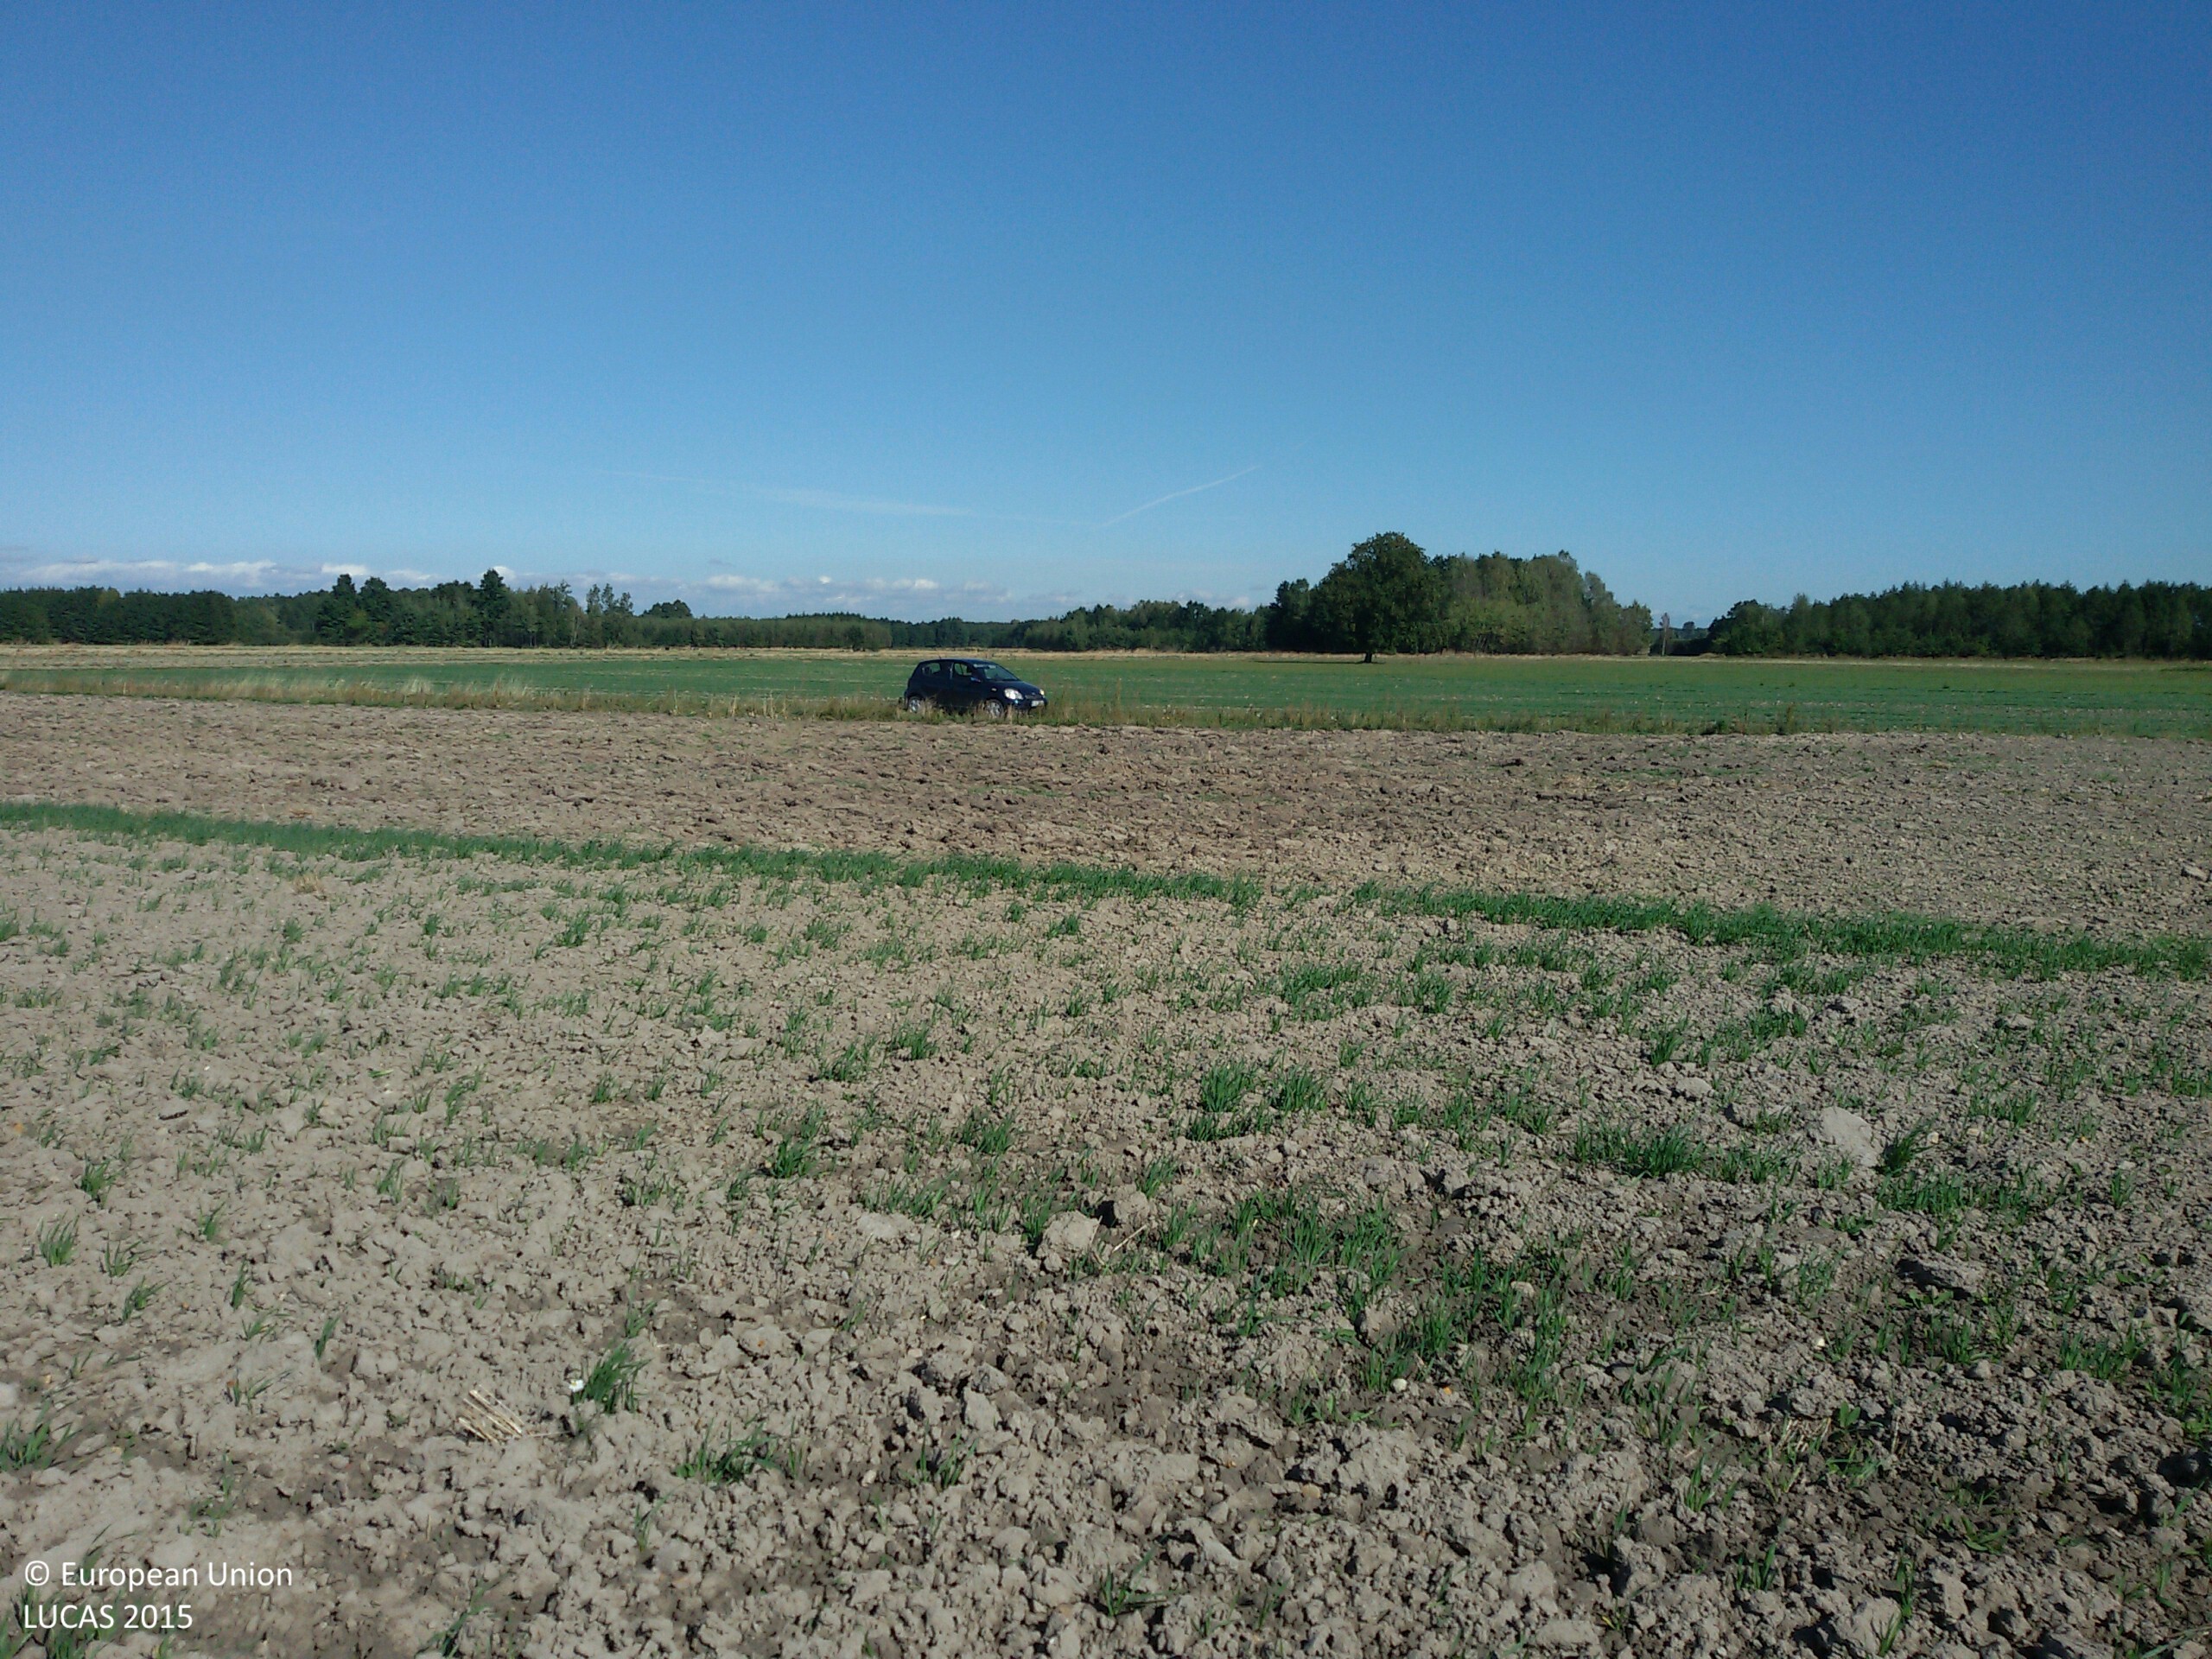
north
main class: Cropland
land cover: Common wheat
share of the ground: < 10 %
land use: Agriculture (excluding fallow land and kitchen gardens)
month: September
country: PL
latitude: 51.0769
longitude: 19.6639
